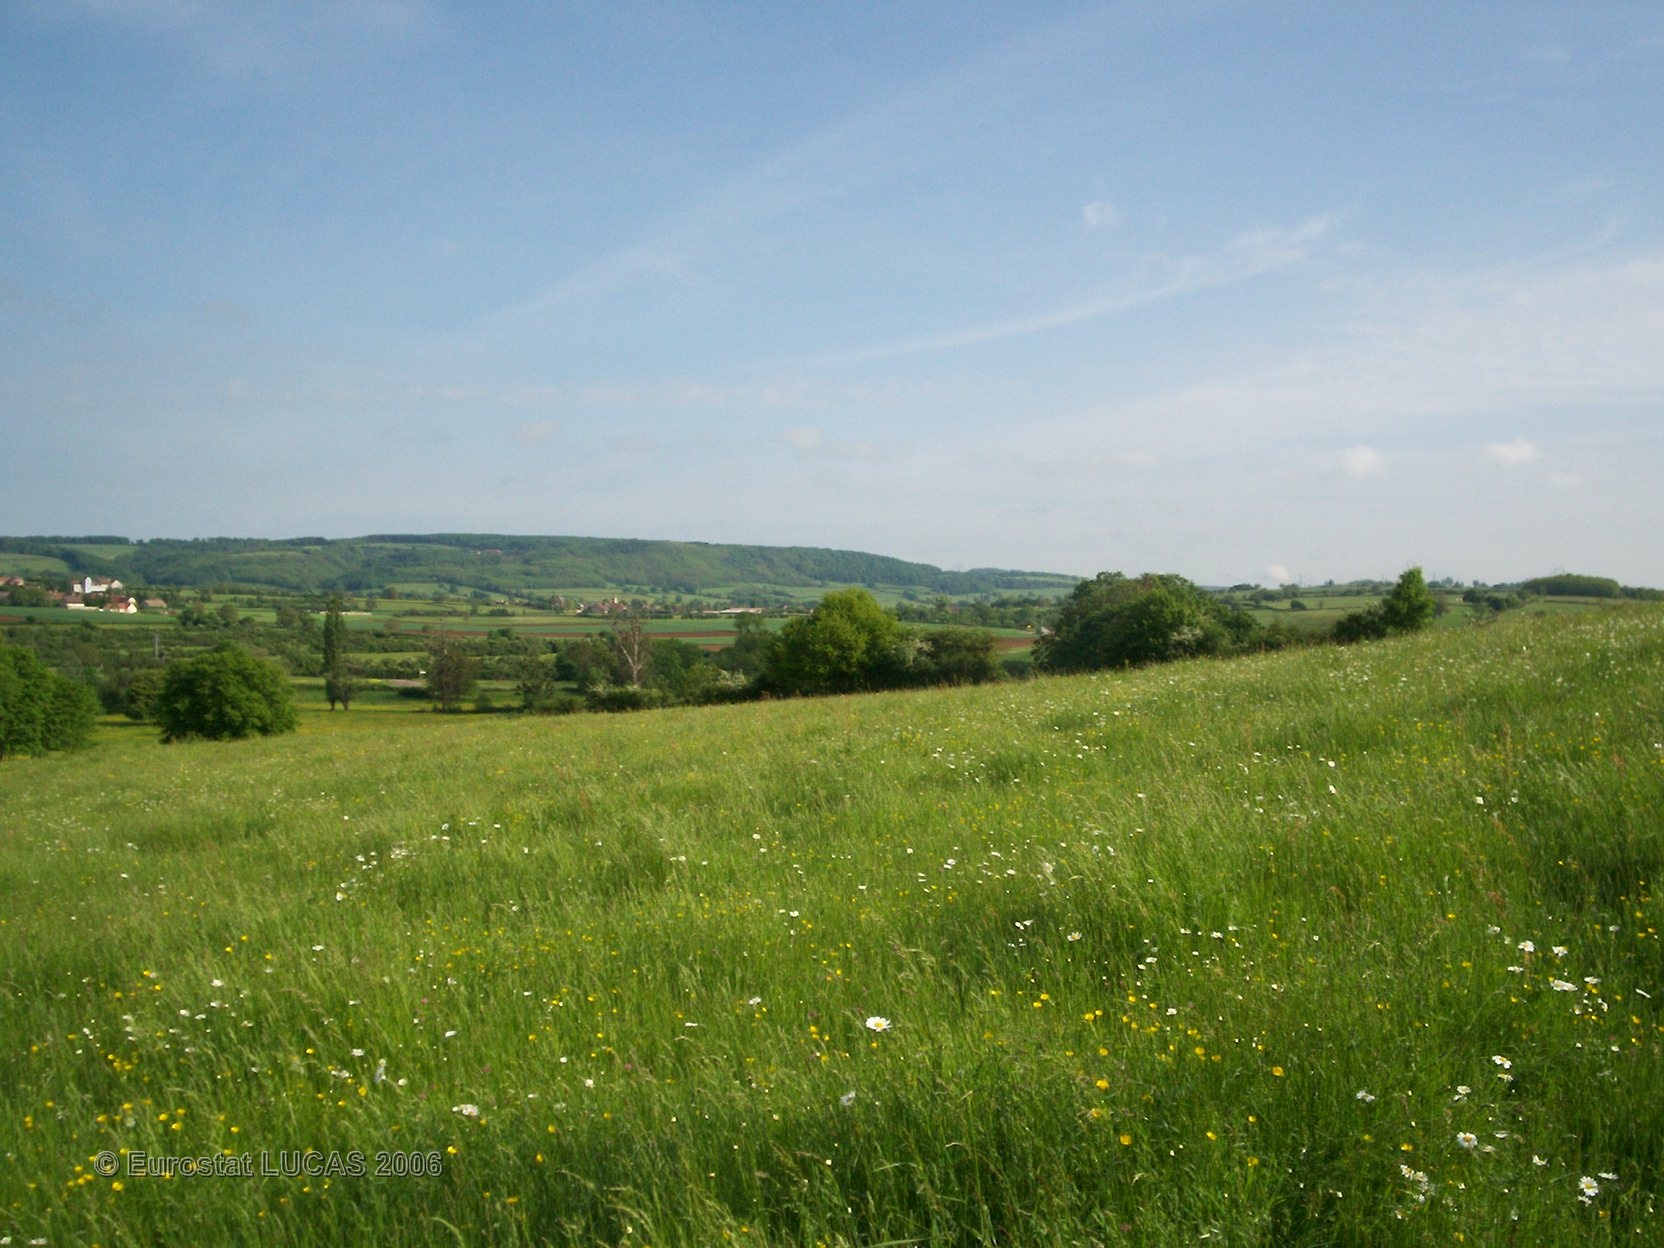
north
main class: Grassland
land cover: Grassland without tree/shrub cover
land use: Agriculture (excluding fallow land and kitchen gardens)
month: May
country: FR
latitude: 46.7406
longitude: 4.6480
